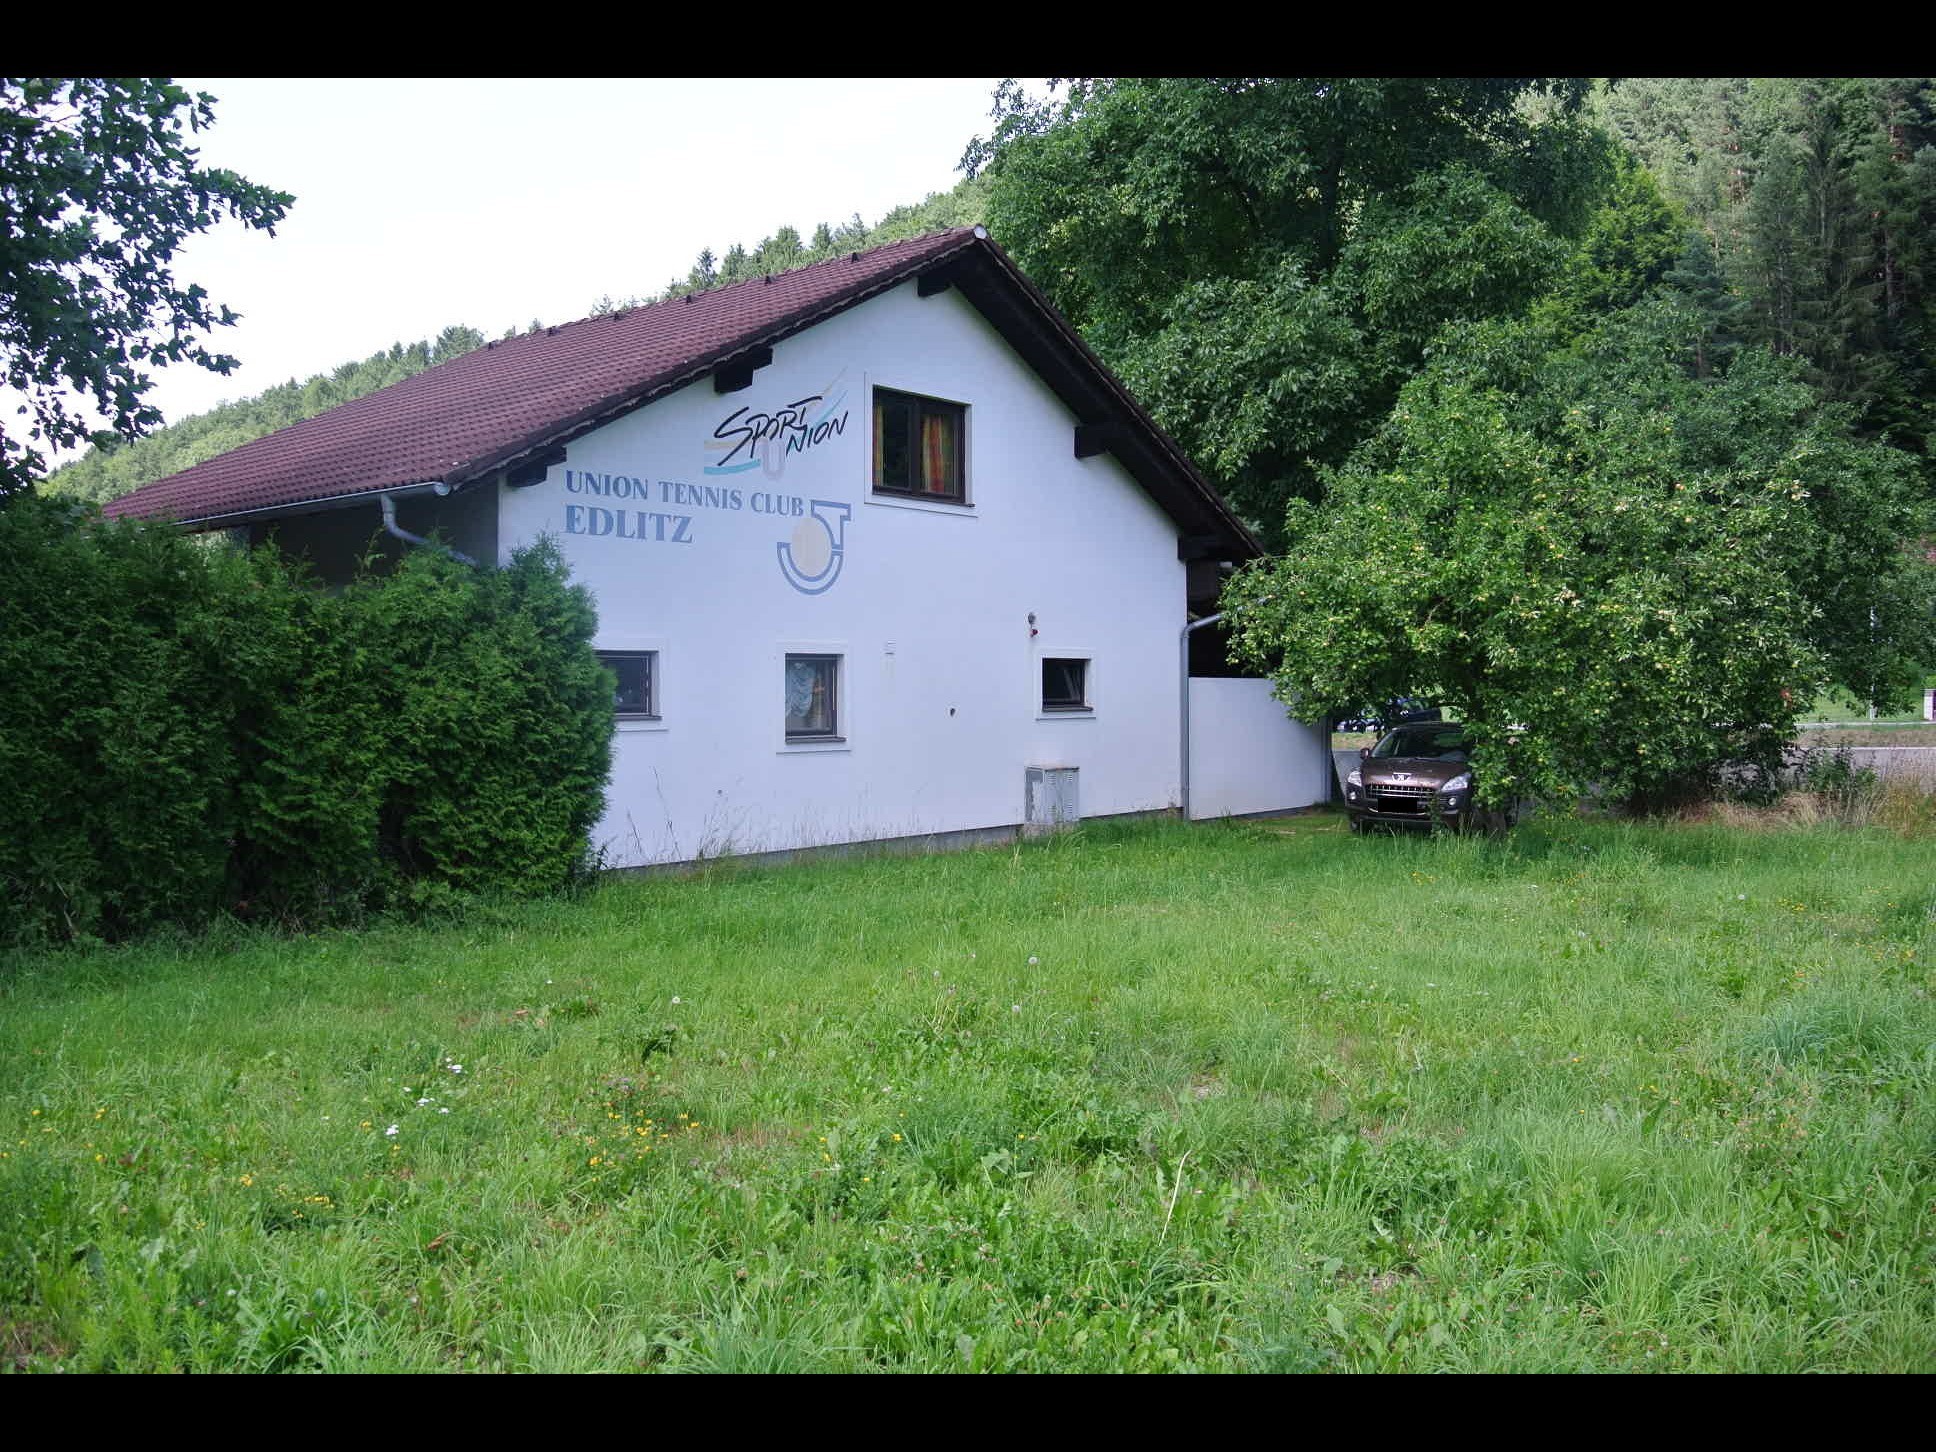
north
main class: Grassland
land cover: Grassland without tree/shrub cover
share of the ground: > 75 %
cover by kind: herbaceous plants 100 %
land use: Abandoned areas
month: July
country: AT
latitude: 47.6015
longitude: 16.1345
